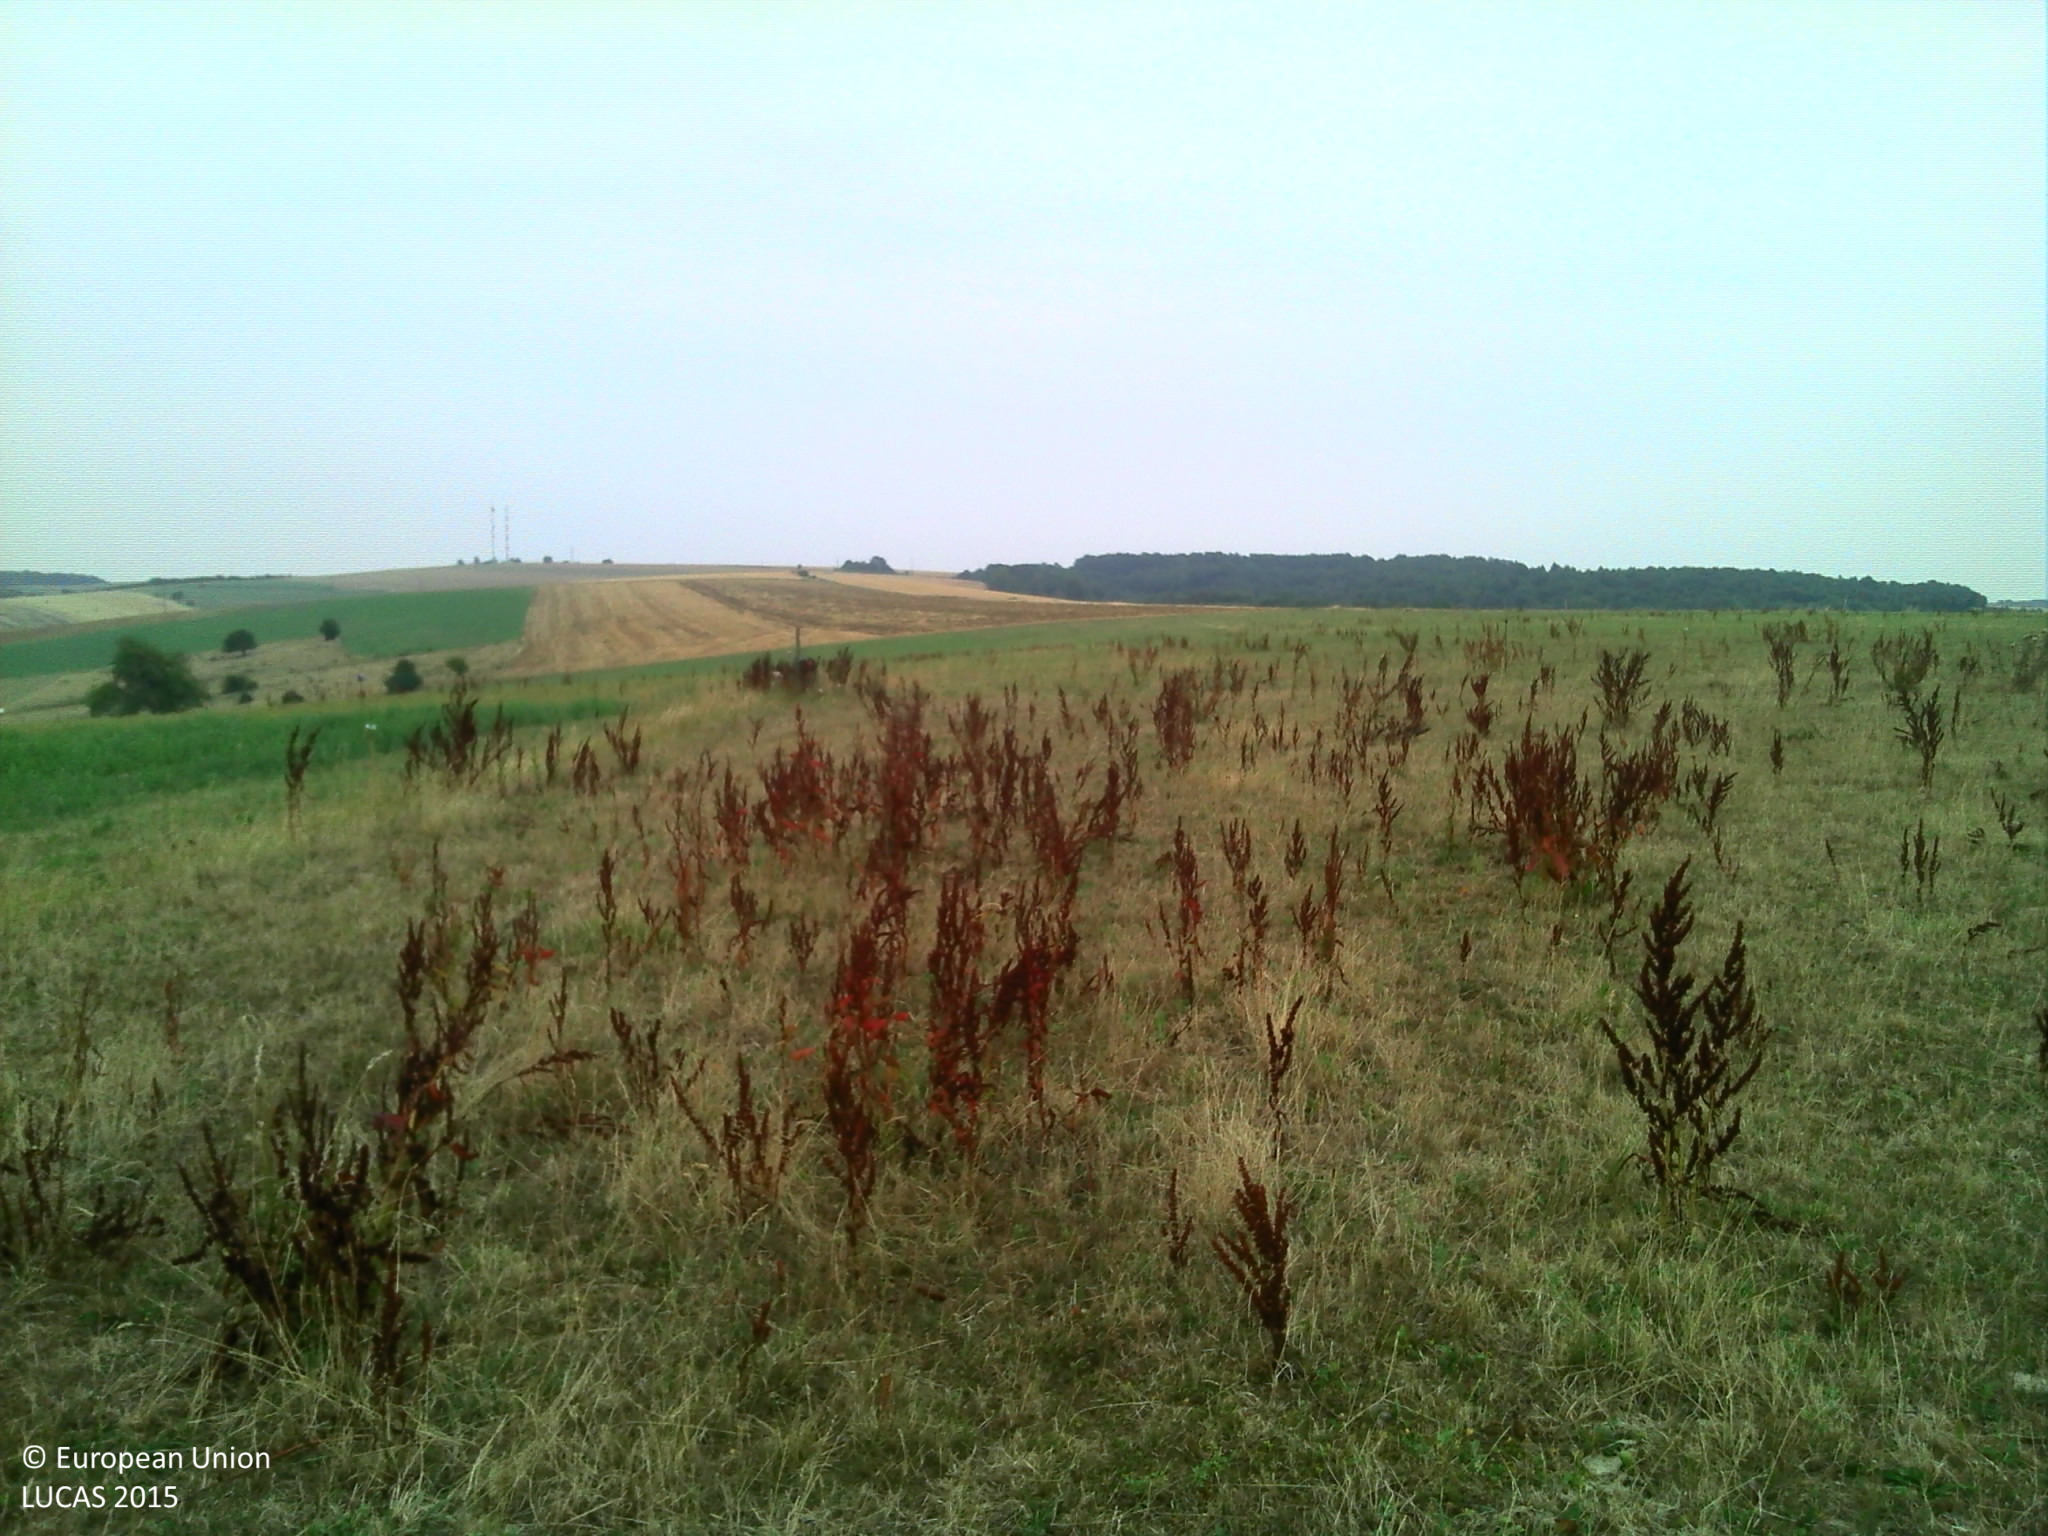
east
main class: Grassland
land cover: Grassland without tree/shrub cover
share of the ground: > 75 %
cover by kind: herbaceous plants 100 %
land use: Agriculture (excluding fallow land and kitchen gardens)
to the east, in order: Grassland without tree/shrub cover; Fences; Grassland without tree/shrub cover
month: August
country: FR
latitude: 49.3478
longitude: 5.2767
